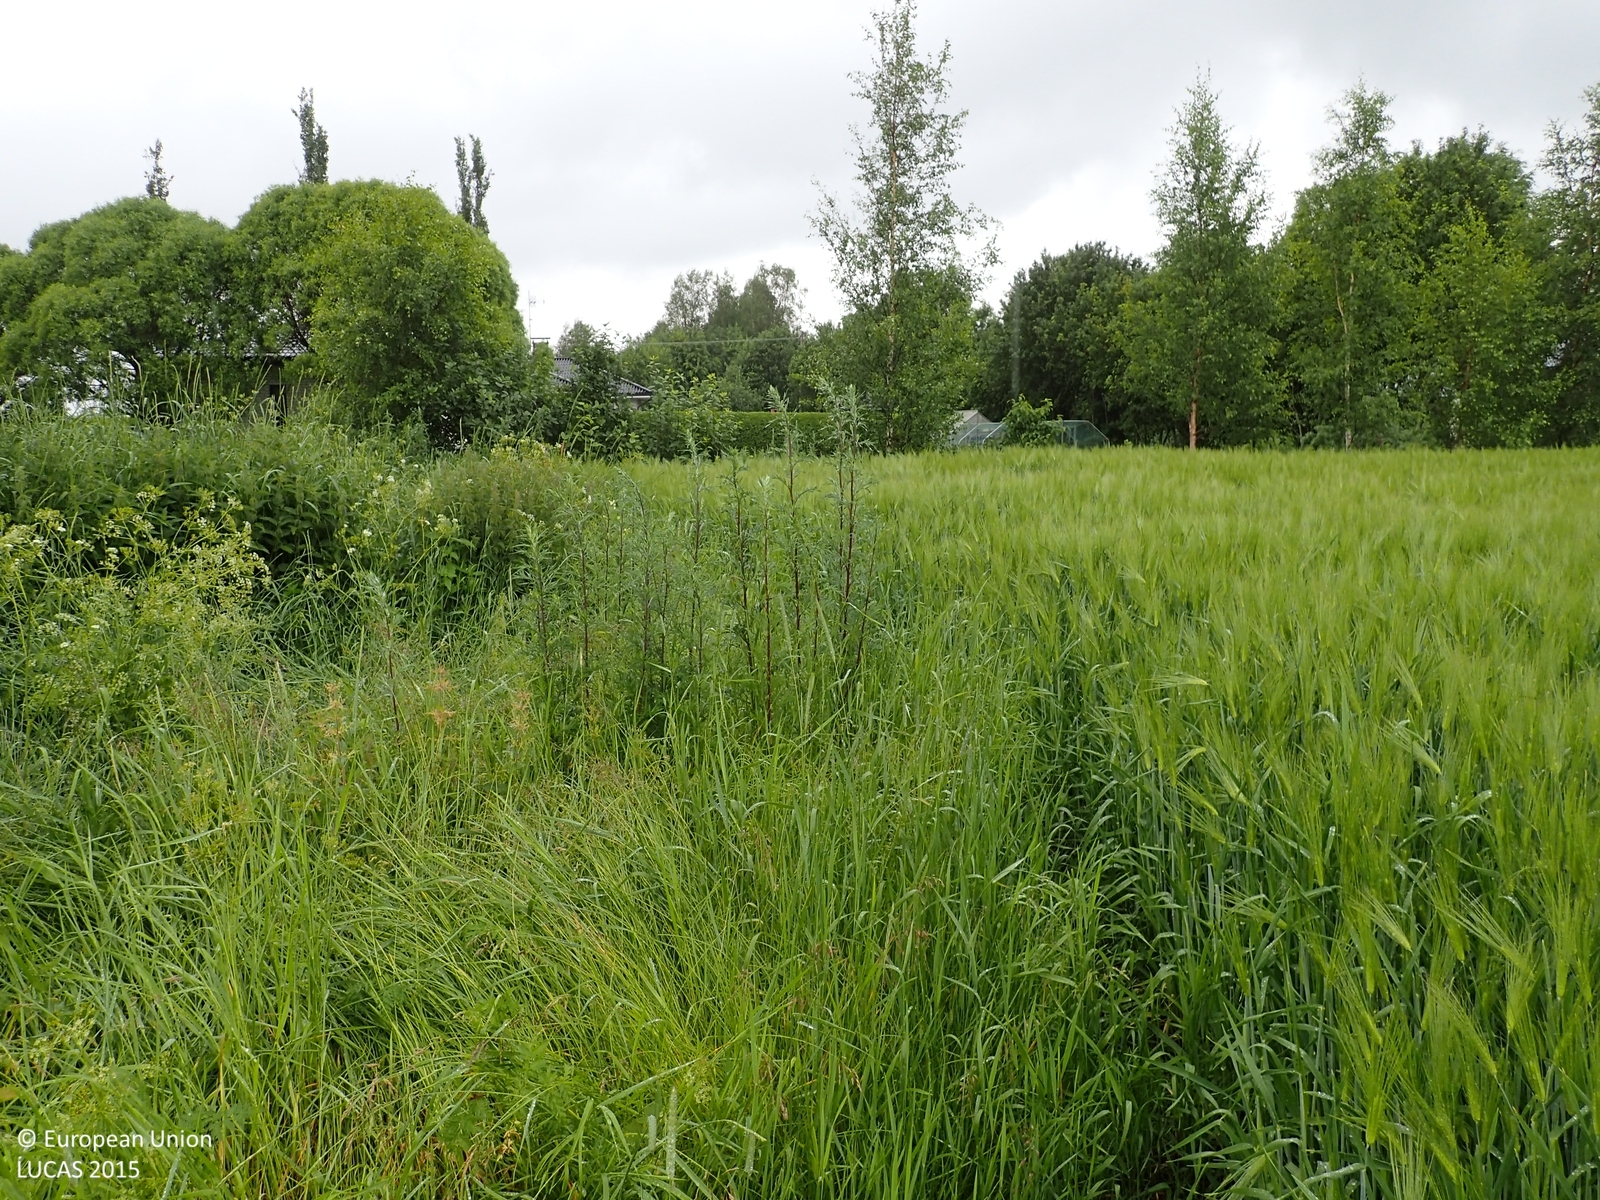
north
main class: Cropland
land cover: Barley
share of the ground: > 75 %
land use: Agriculture (excluding fallow land and kitchen gardens)
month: July
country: FI
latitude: 62.9970
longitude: 21.9088
